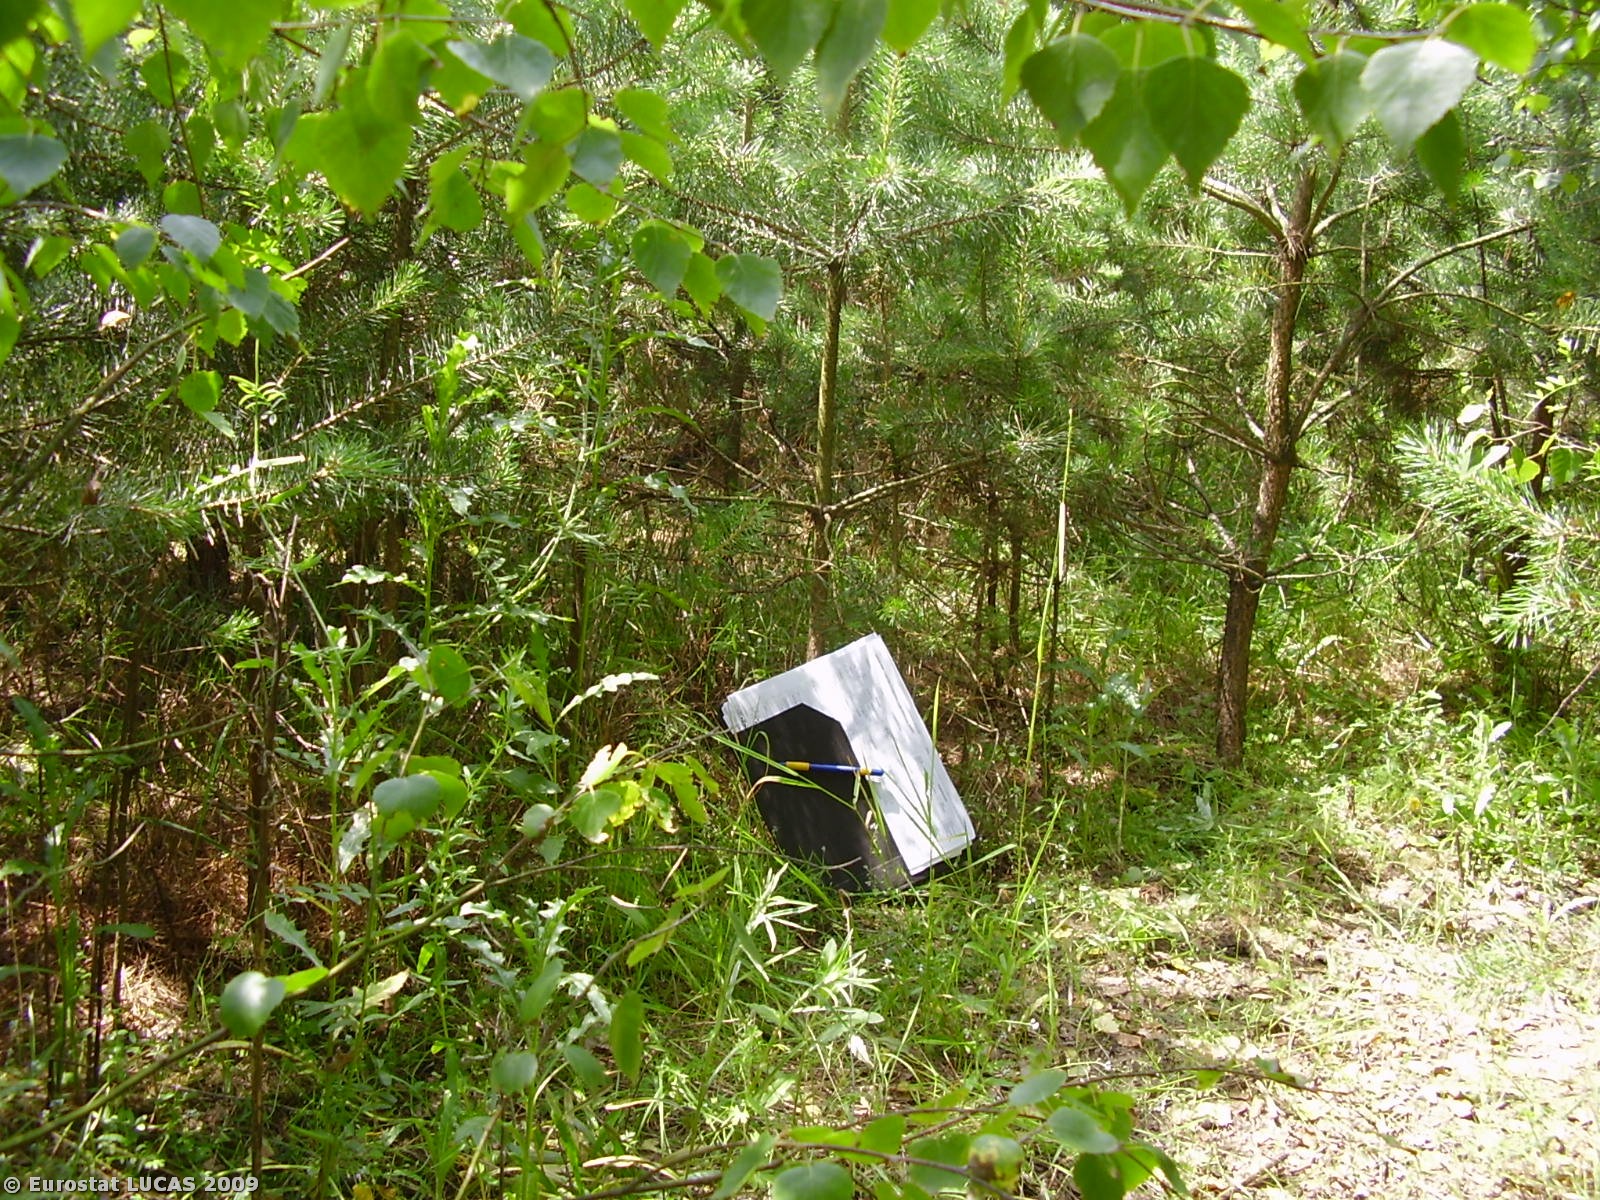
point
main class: Woodland
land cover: Mixed woodland
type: hemiboreal forest and nemoral coniferous forest and mixed broadleaved-coniferous forest
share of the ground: > 75 %
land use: Forestry
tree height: > 5 m
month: July
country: PL
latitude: 51.4209
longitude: 17.9971
